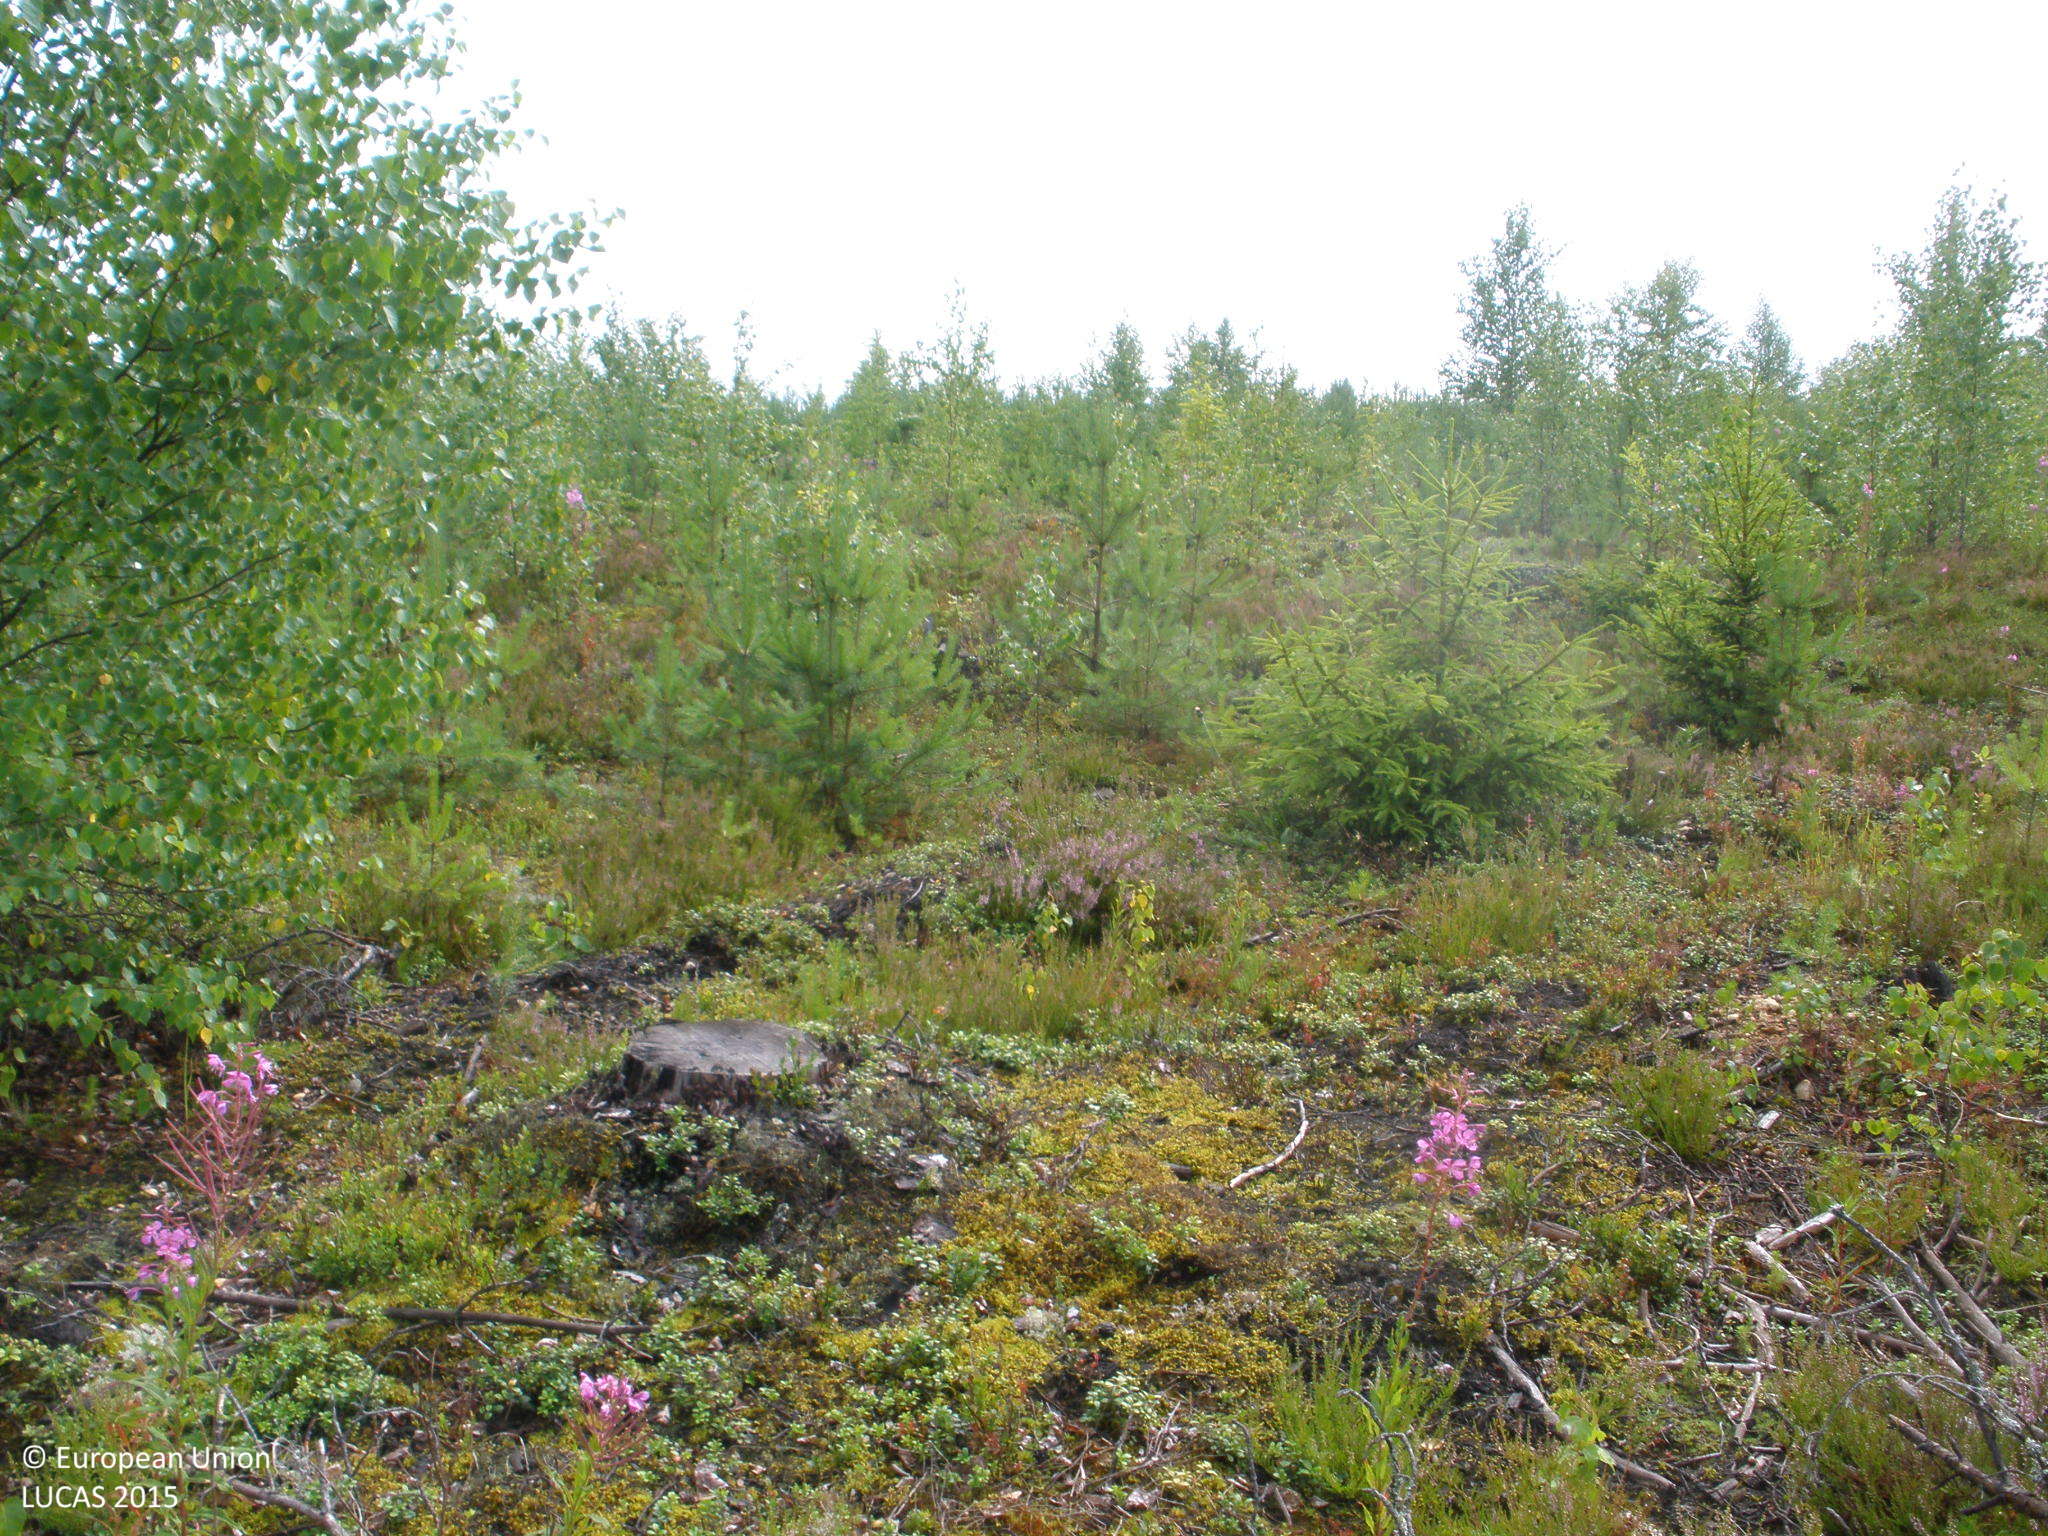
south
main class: Woodland
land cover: Pine dominated mixed woodland
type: boreal forest
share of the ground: 25 - 50 %
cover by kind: lichens and mosses 30 %, broadleaved forest trees 25 %, coniferous forest trees 20 %, shrubs 10 %, herbaceous plants 10 %, unconsolidated bare surface 5 %
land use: Forestry
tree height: < 5 m
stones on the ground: 10 - 25 %
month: July
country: FI
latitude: 61.2208
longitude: 24.7224
